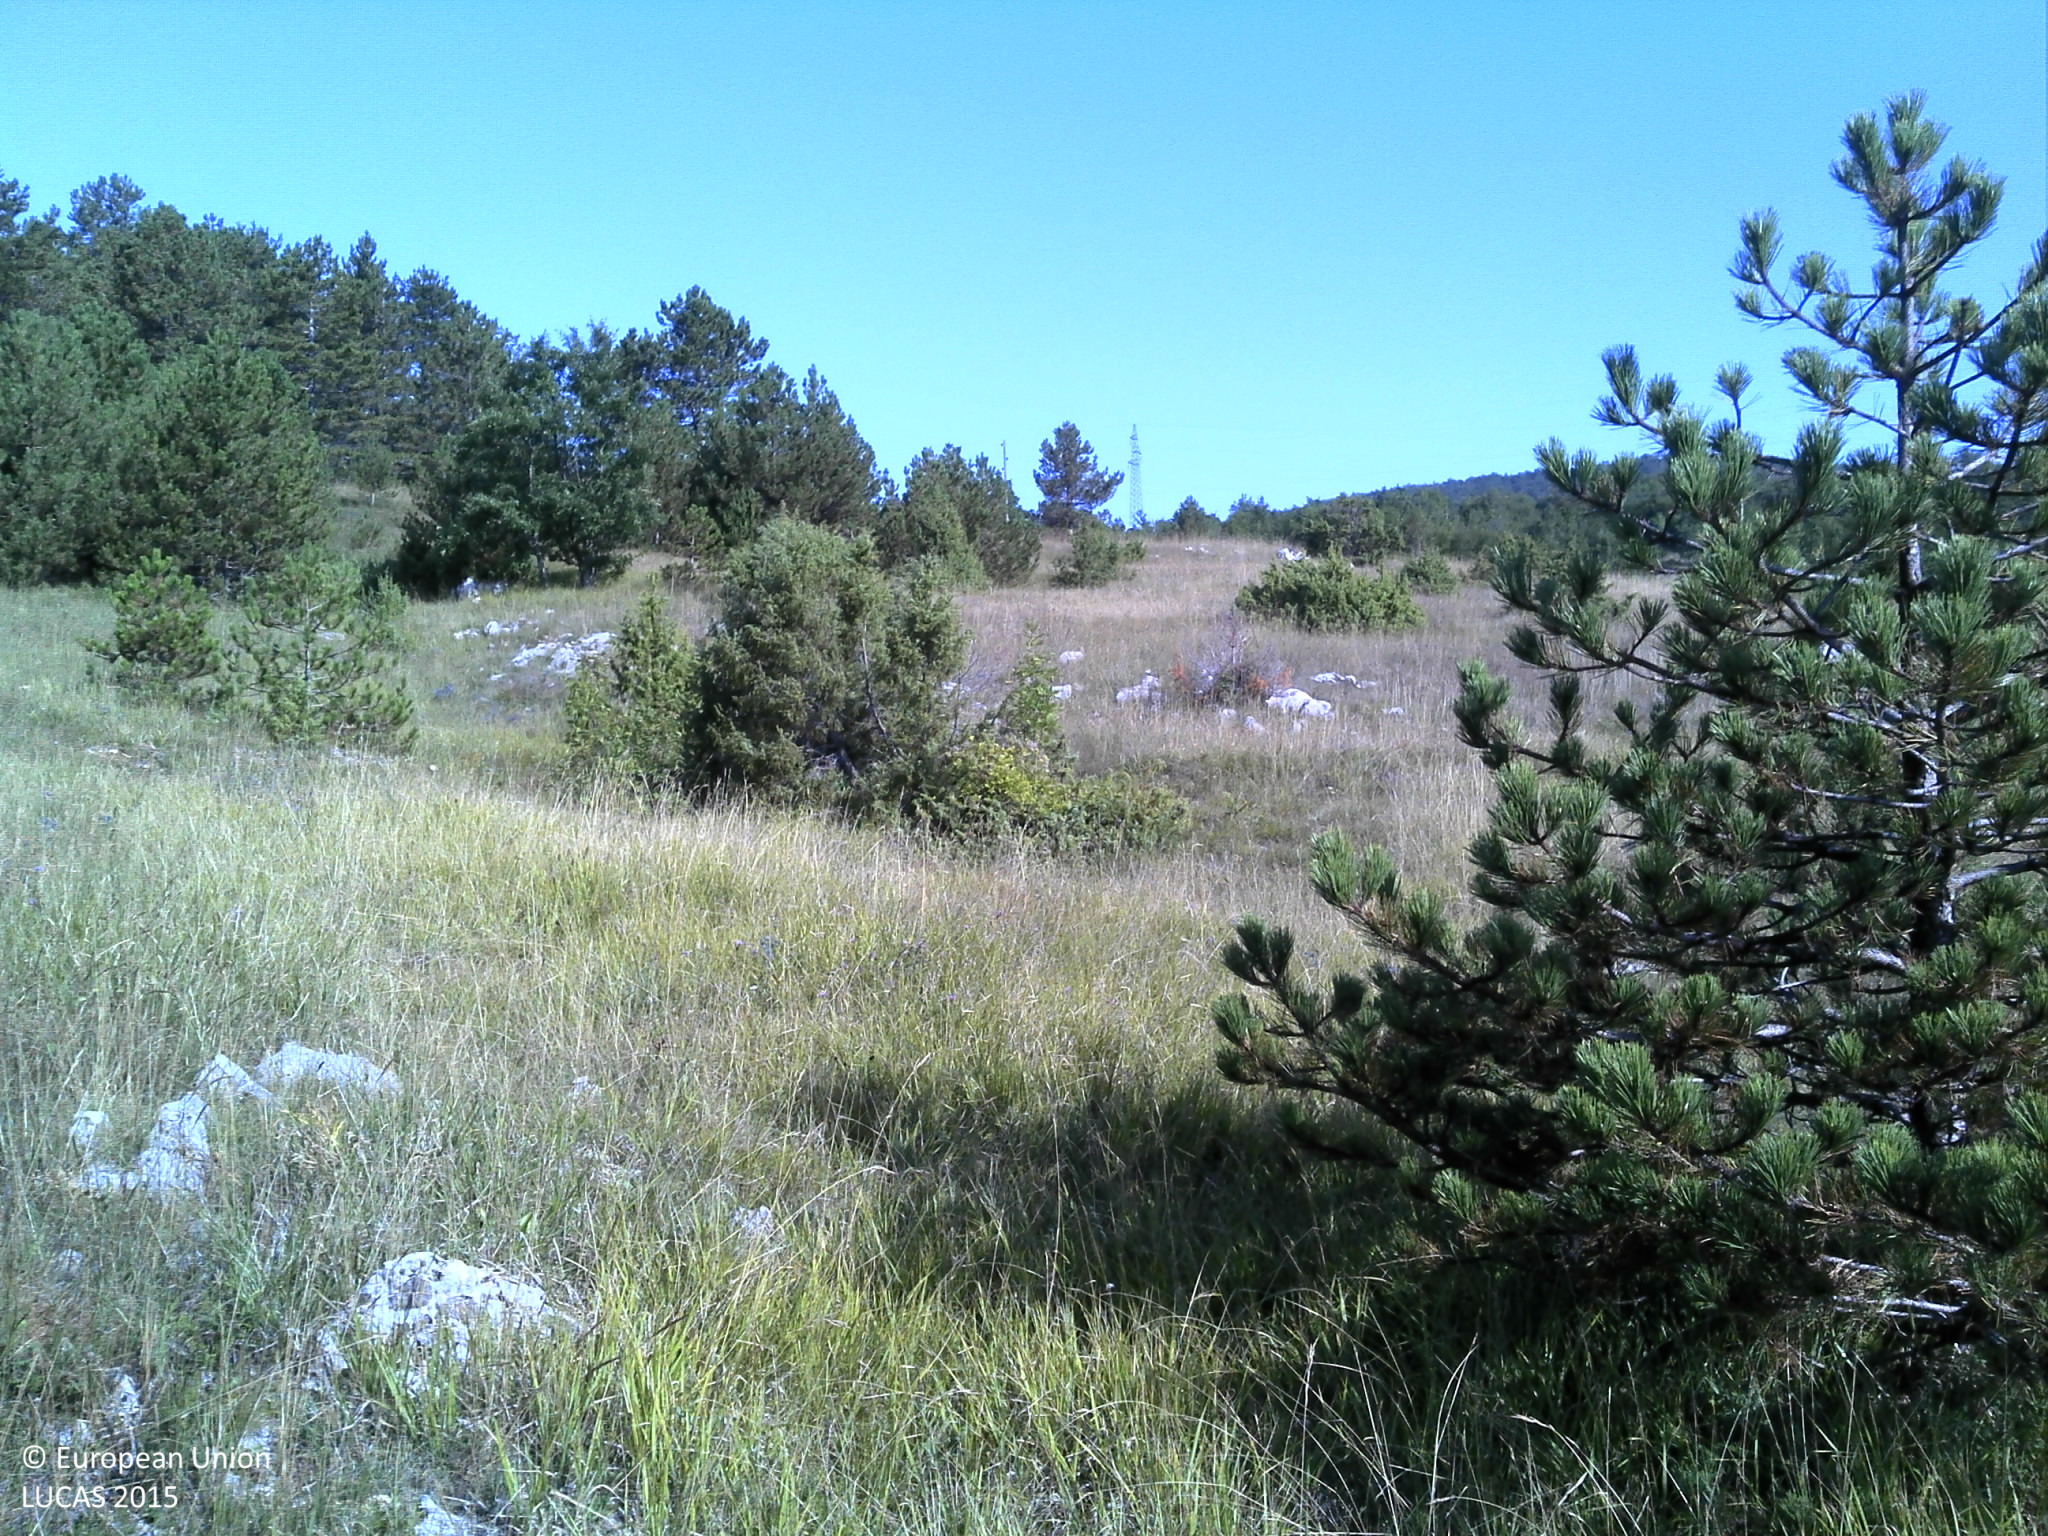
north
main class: Grassland
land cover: Grassland with sparse tree/shrub cover
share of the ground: > 75 %
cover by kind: herbaceous plants 80 %, shrubs 10 %, coniferous forest trees 5 %, unconsolidated bare surface 5 %
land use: Abandoned areas
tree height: < 5 m
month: August
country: HR
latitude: 44.2691
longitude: 15.9687
